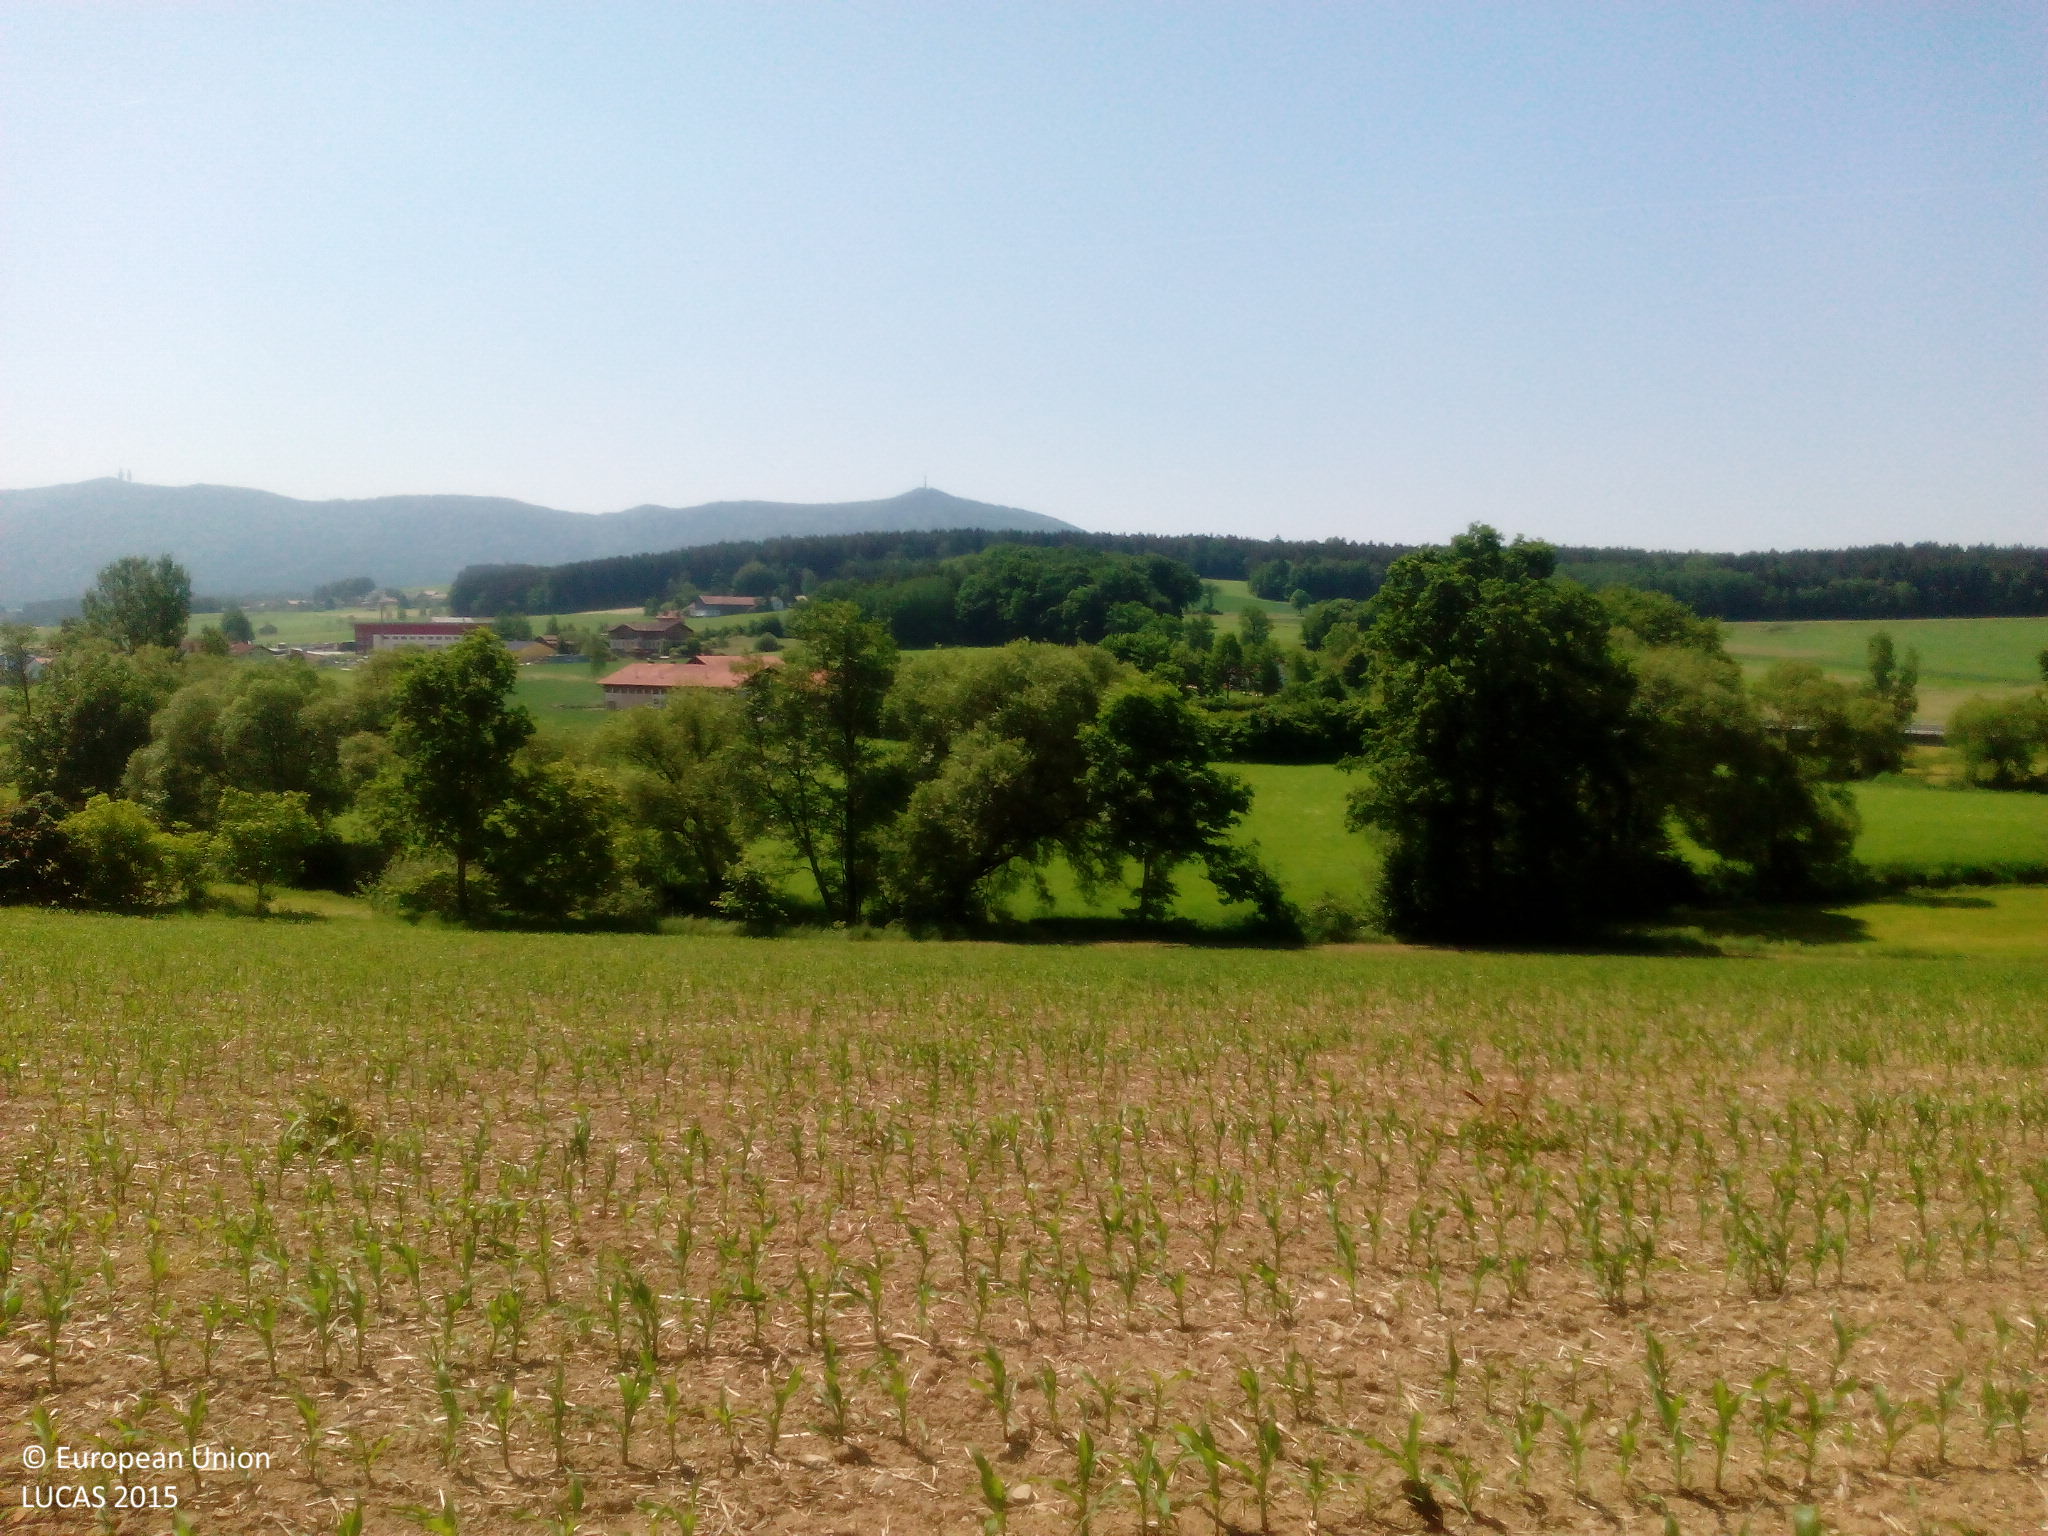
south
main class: Cropland
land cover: Maize
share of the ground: 10 - 25 %
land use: Agriculture (excluding fallow land and kitchen gardens)
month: June
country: DE
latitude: 49.3015
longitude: 12.9014
